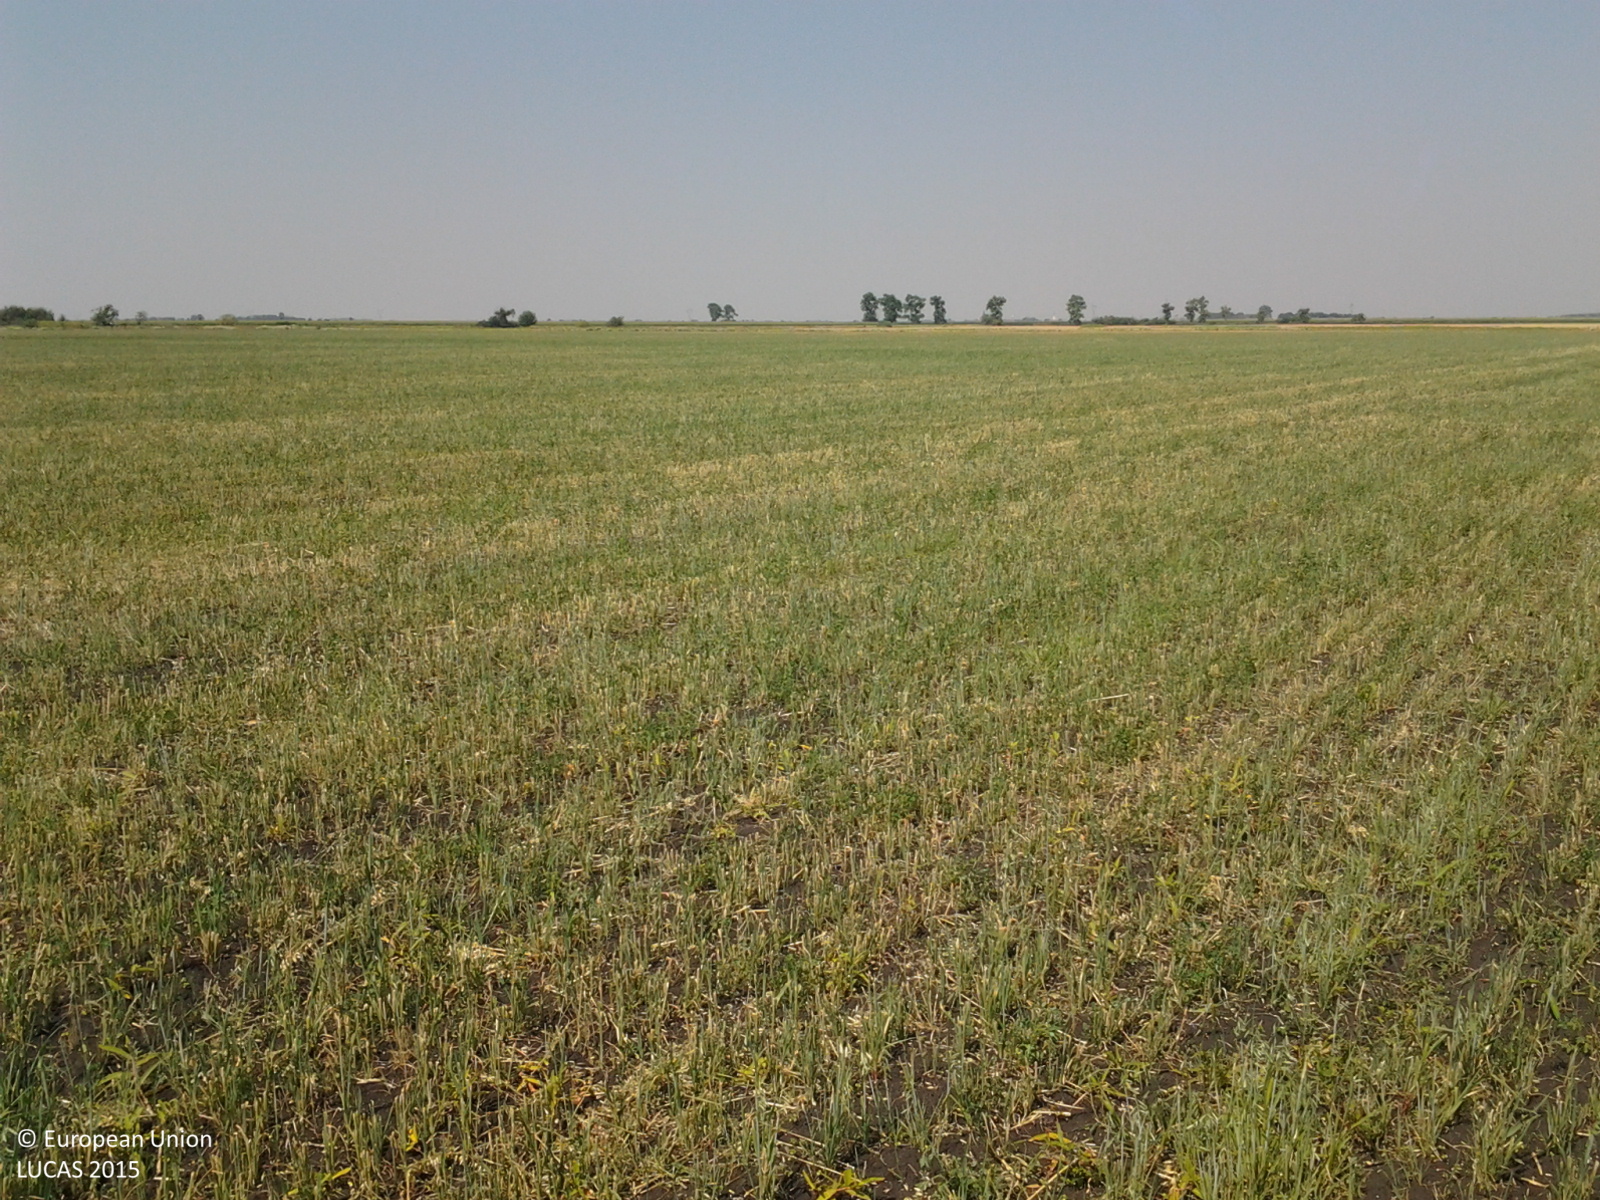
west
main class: Cropland
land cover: Oats
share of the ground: < 10 %
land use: Agriculture (excluding fallow land and kitchen gardens)
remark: Harvested field
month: July
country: HU
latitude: 47.4514
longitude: 20.2809
